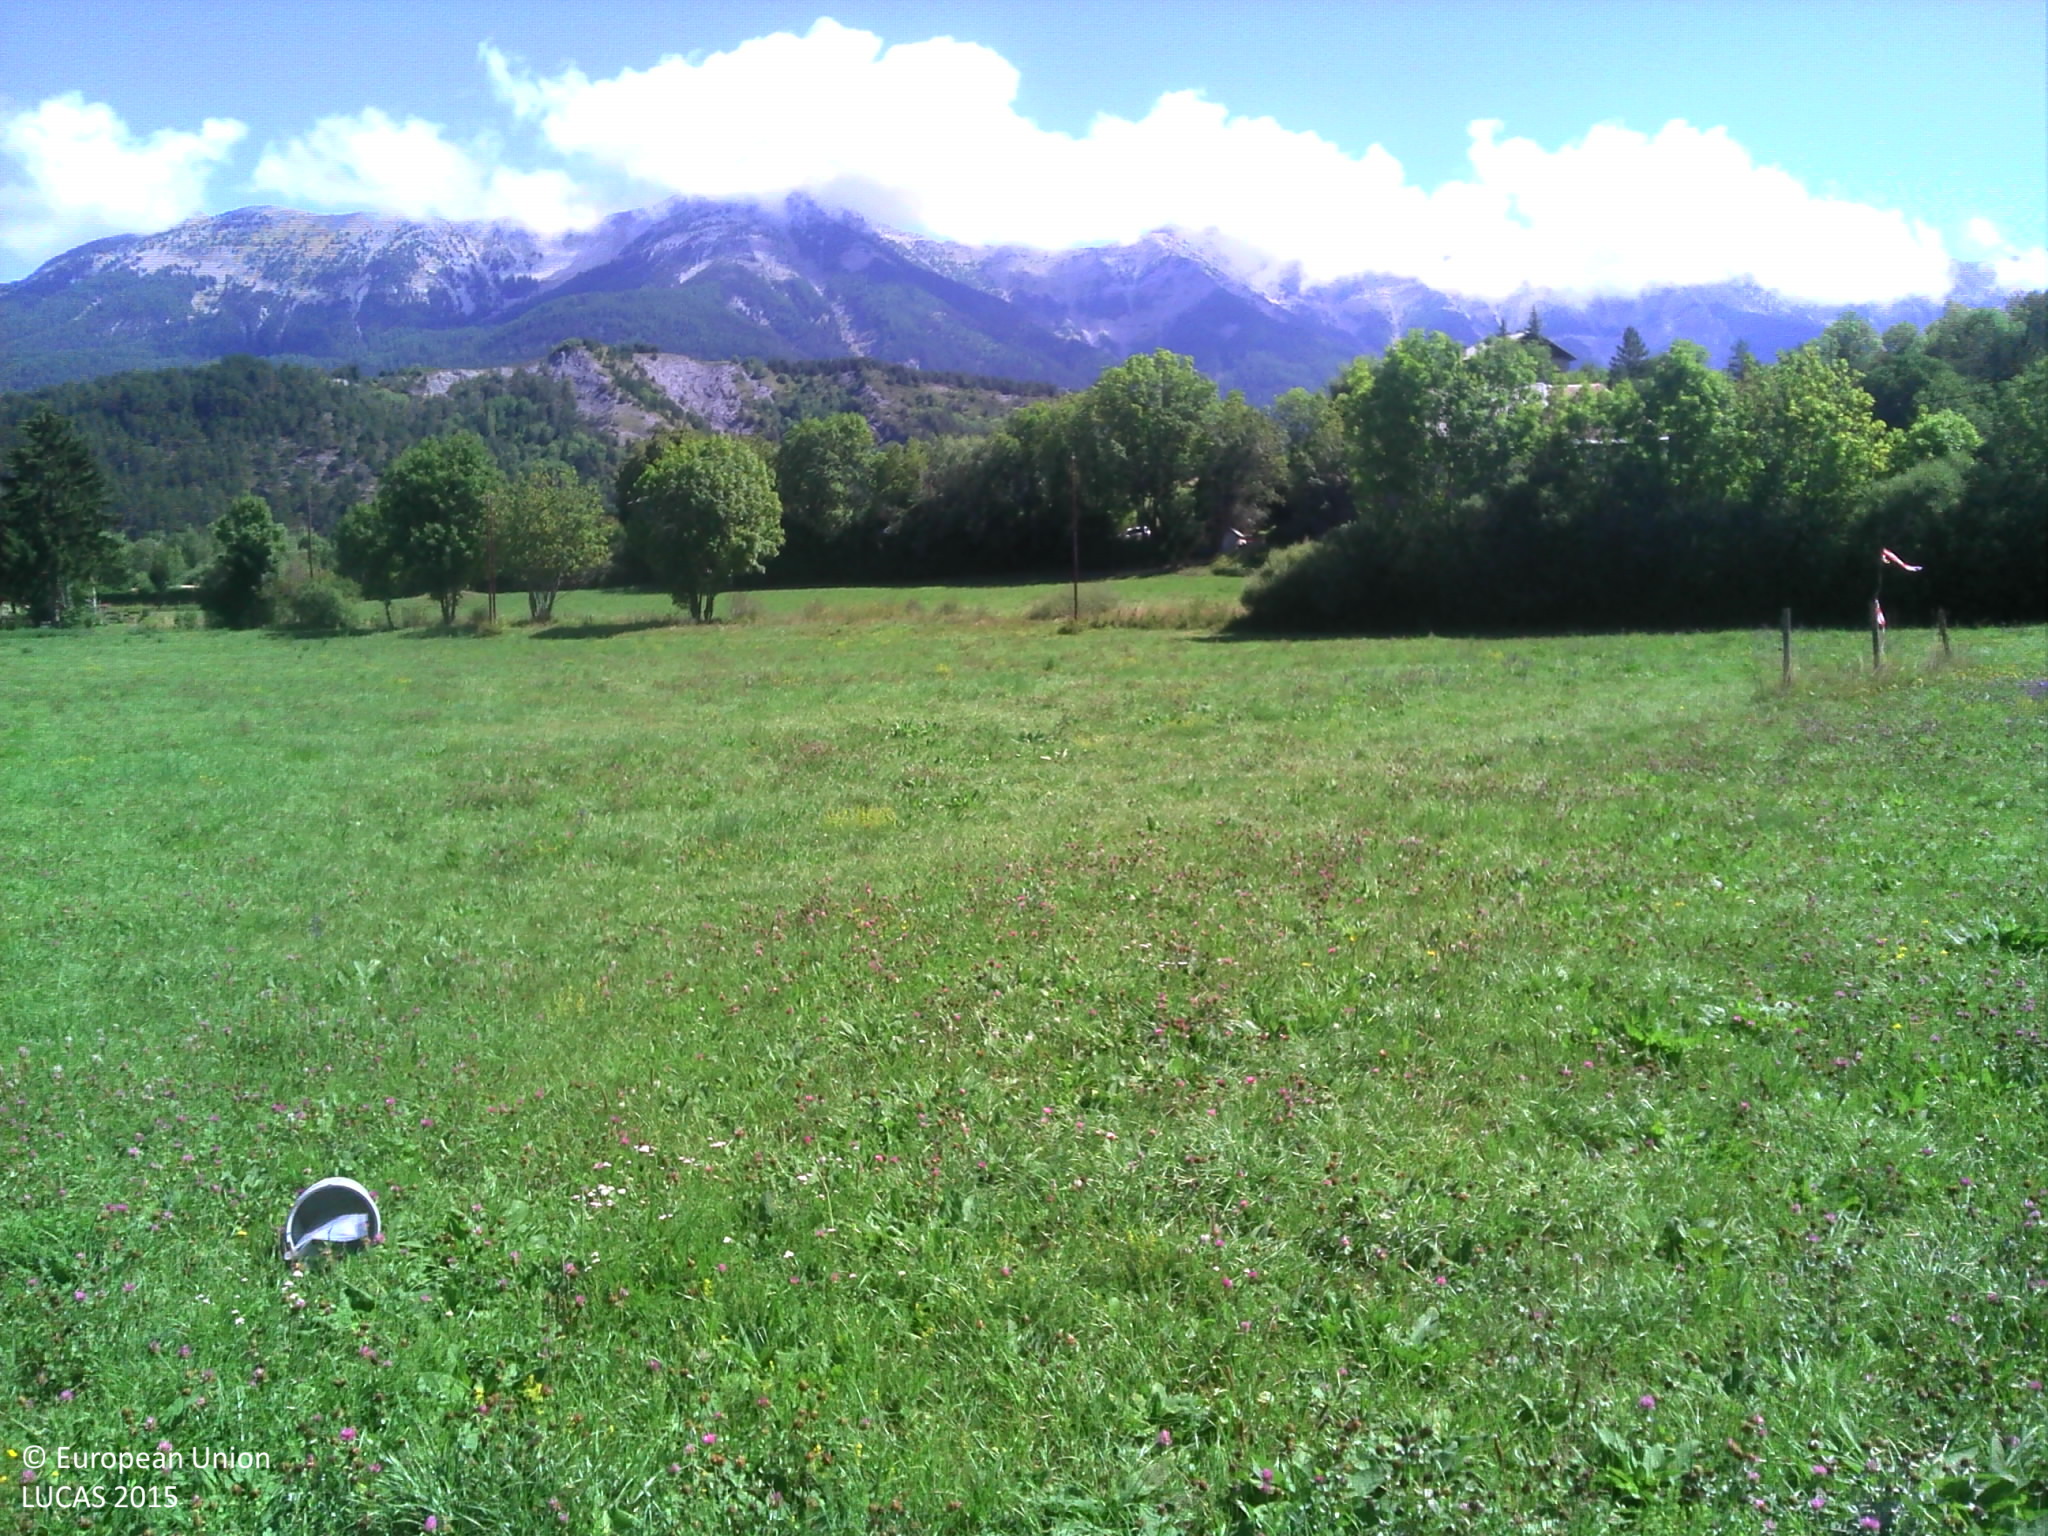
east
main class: Grassland
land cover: Grassland without tree/shrub cover
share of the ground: > 75 %
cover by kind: herbaceous plants 100 %
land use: Agriculture (excluding fallow land and kitchen gardens)
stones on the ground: < 10 %
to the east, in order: Grassland without tree/shrub cover; Electric lines; Lines of trees; Paved roads, cycling and walking lanes; Grass margins; Ditches and canals; Grass margins; Electric lines; Grassland without tree/shrub cover; Broadleaved woodland; Fences; Tracks; Pine dominated coniferous woodland
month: August
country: FR
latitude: 44.3408
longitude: 6.3569
